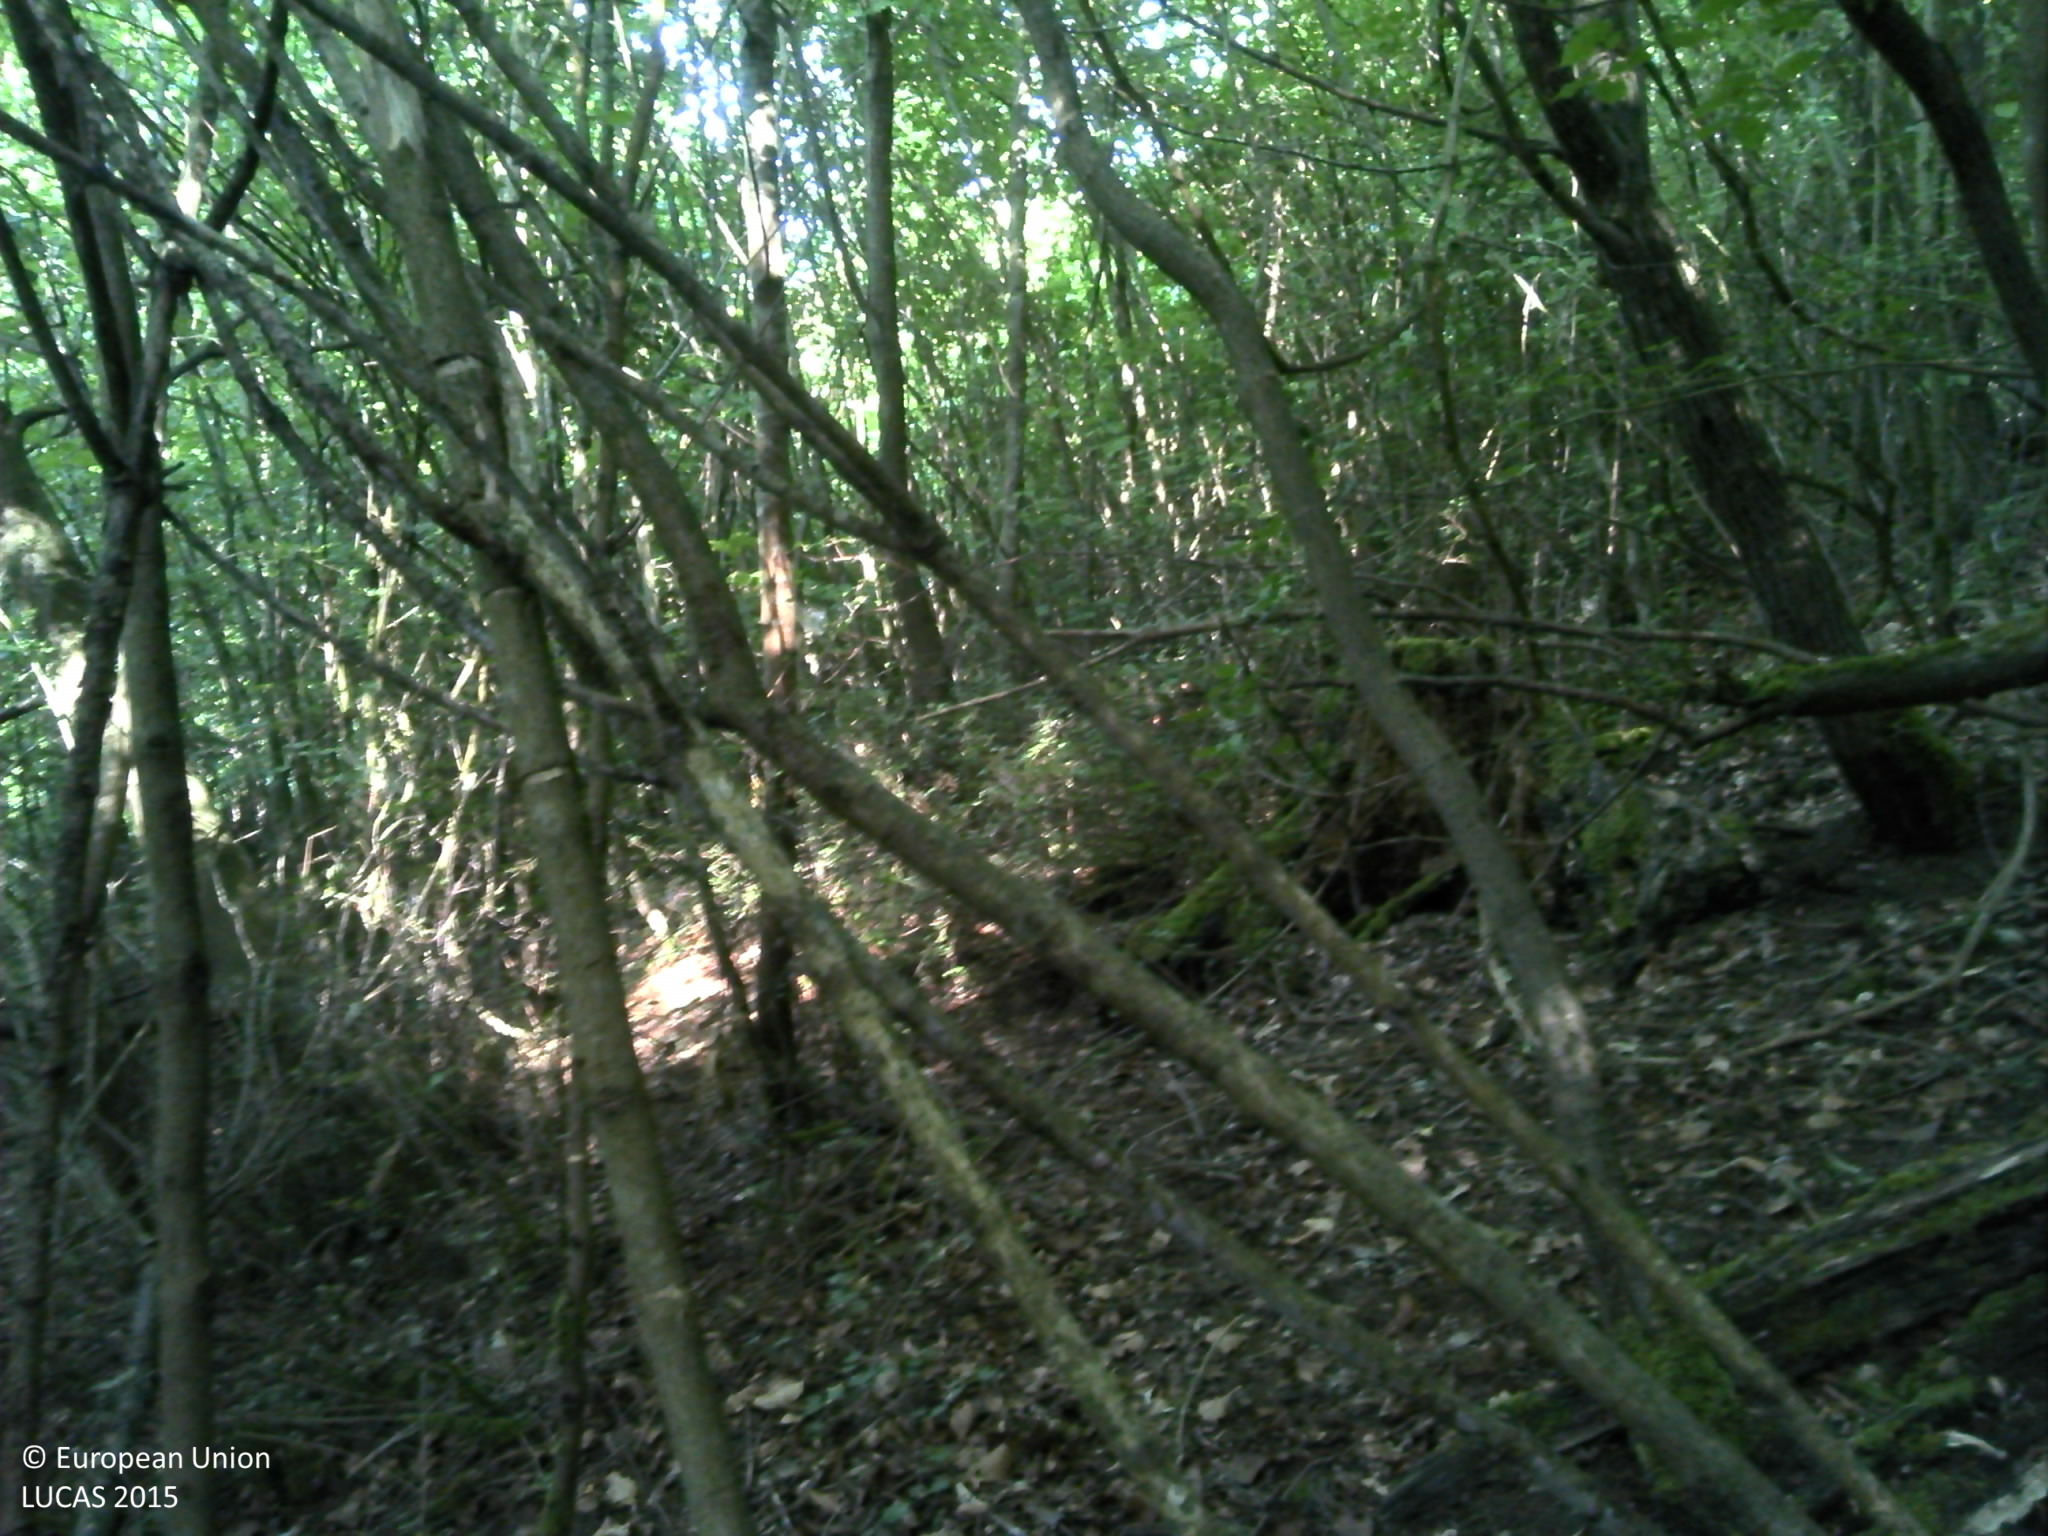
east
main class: Woodland
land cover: Broadleaved woodland
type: beech forest
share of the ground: > 75 %
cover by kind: broadleaved forest trees 100 %
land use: Forestry
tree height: > 5 m
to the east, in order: Broadleaved woodland; Tracks; Broadleaved woodland
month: June
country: FR
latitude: 49.2168
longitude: 6.0869
